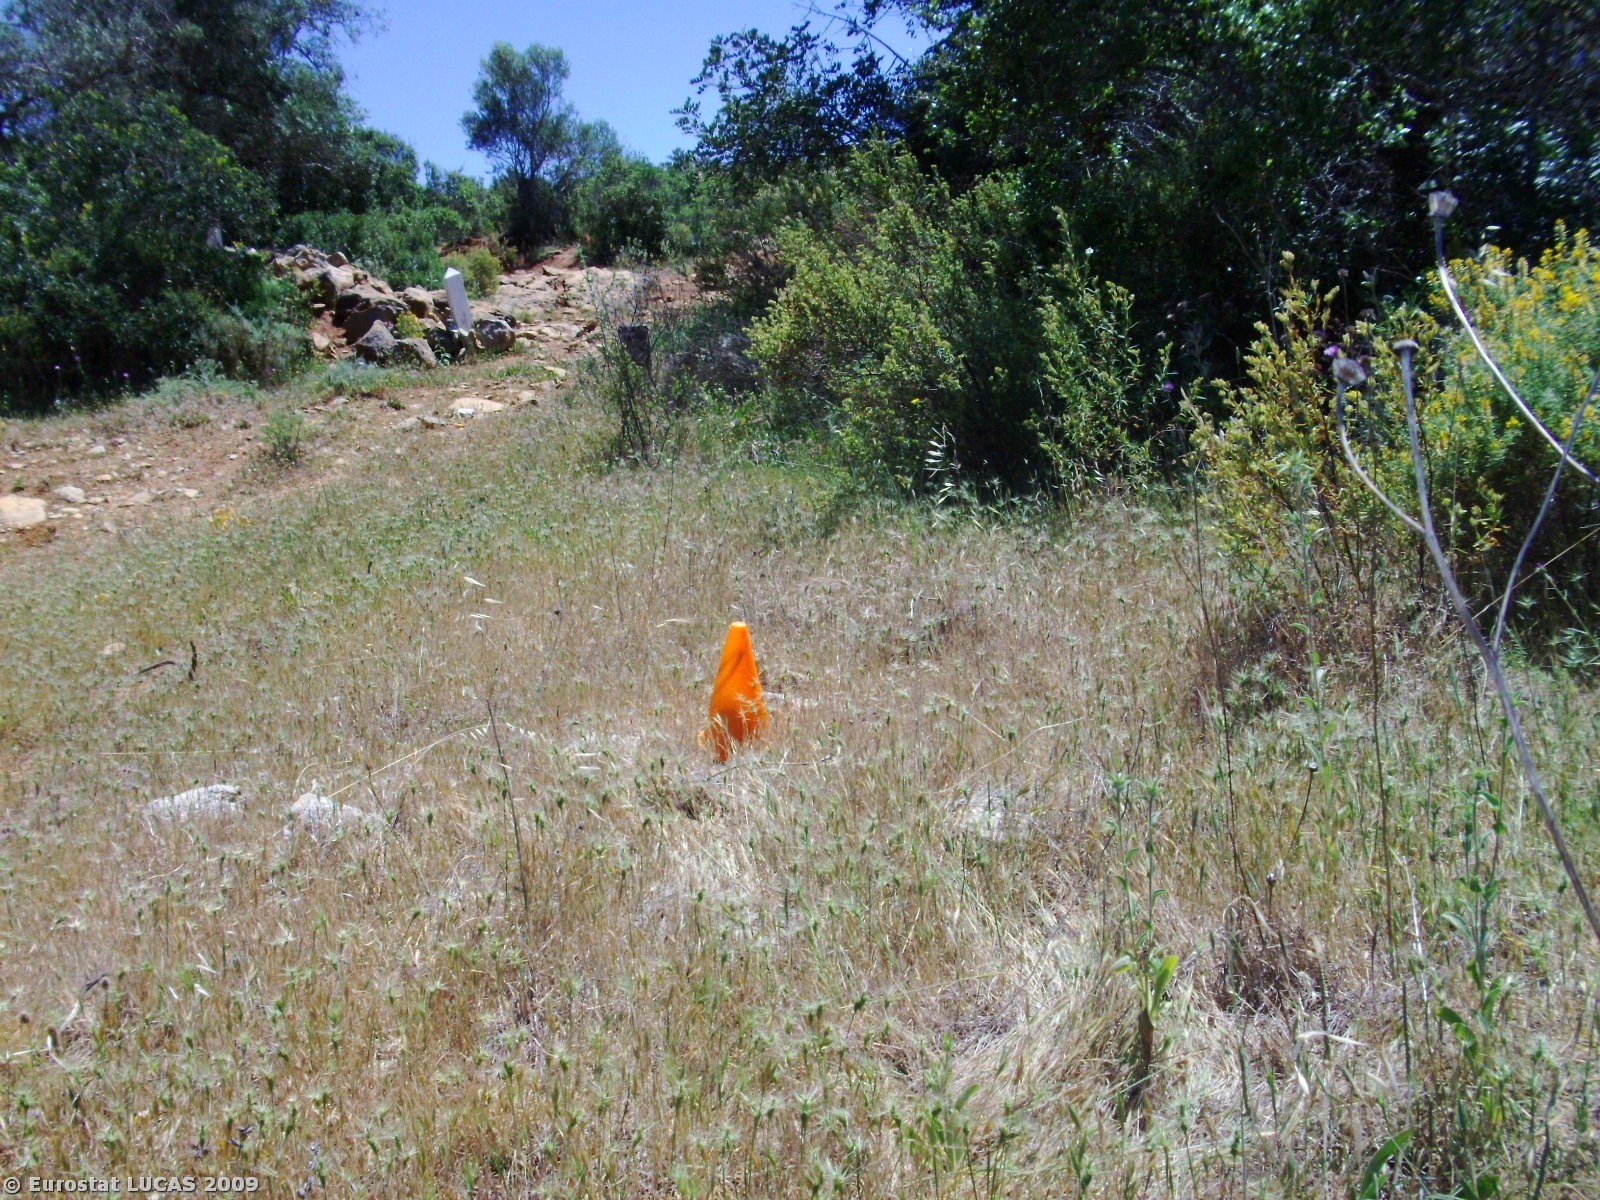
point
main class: Grassland
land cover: Grassland with sparse tree/shrub cover
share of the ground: > 75 %
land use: Fallow land
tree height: > 5 m
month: May
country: PT
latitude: 37.1432
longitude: -8.3839
